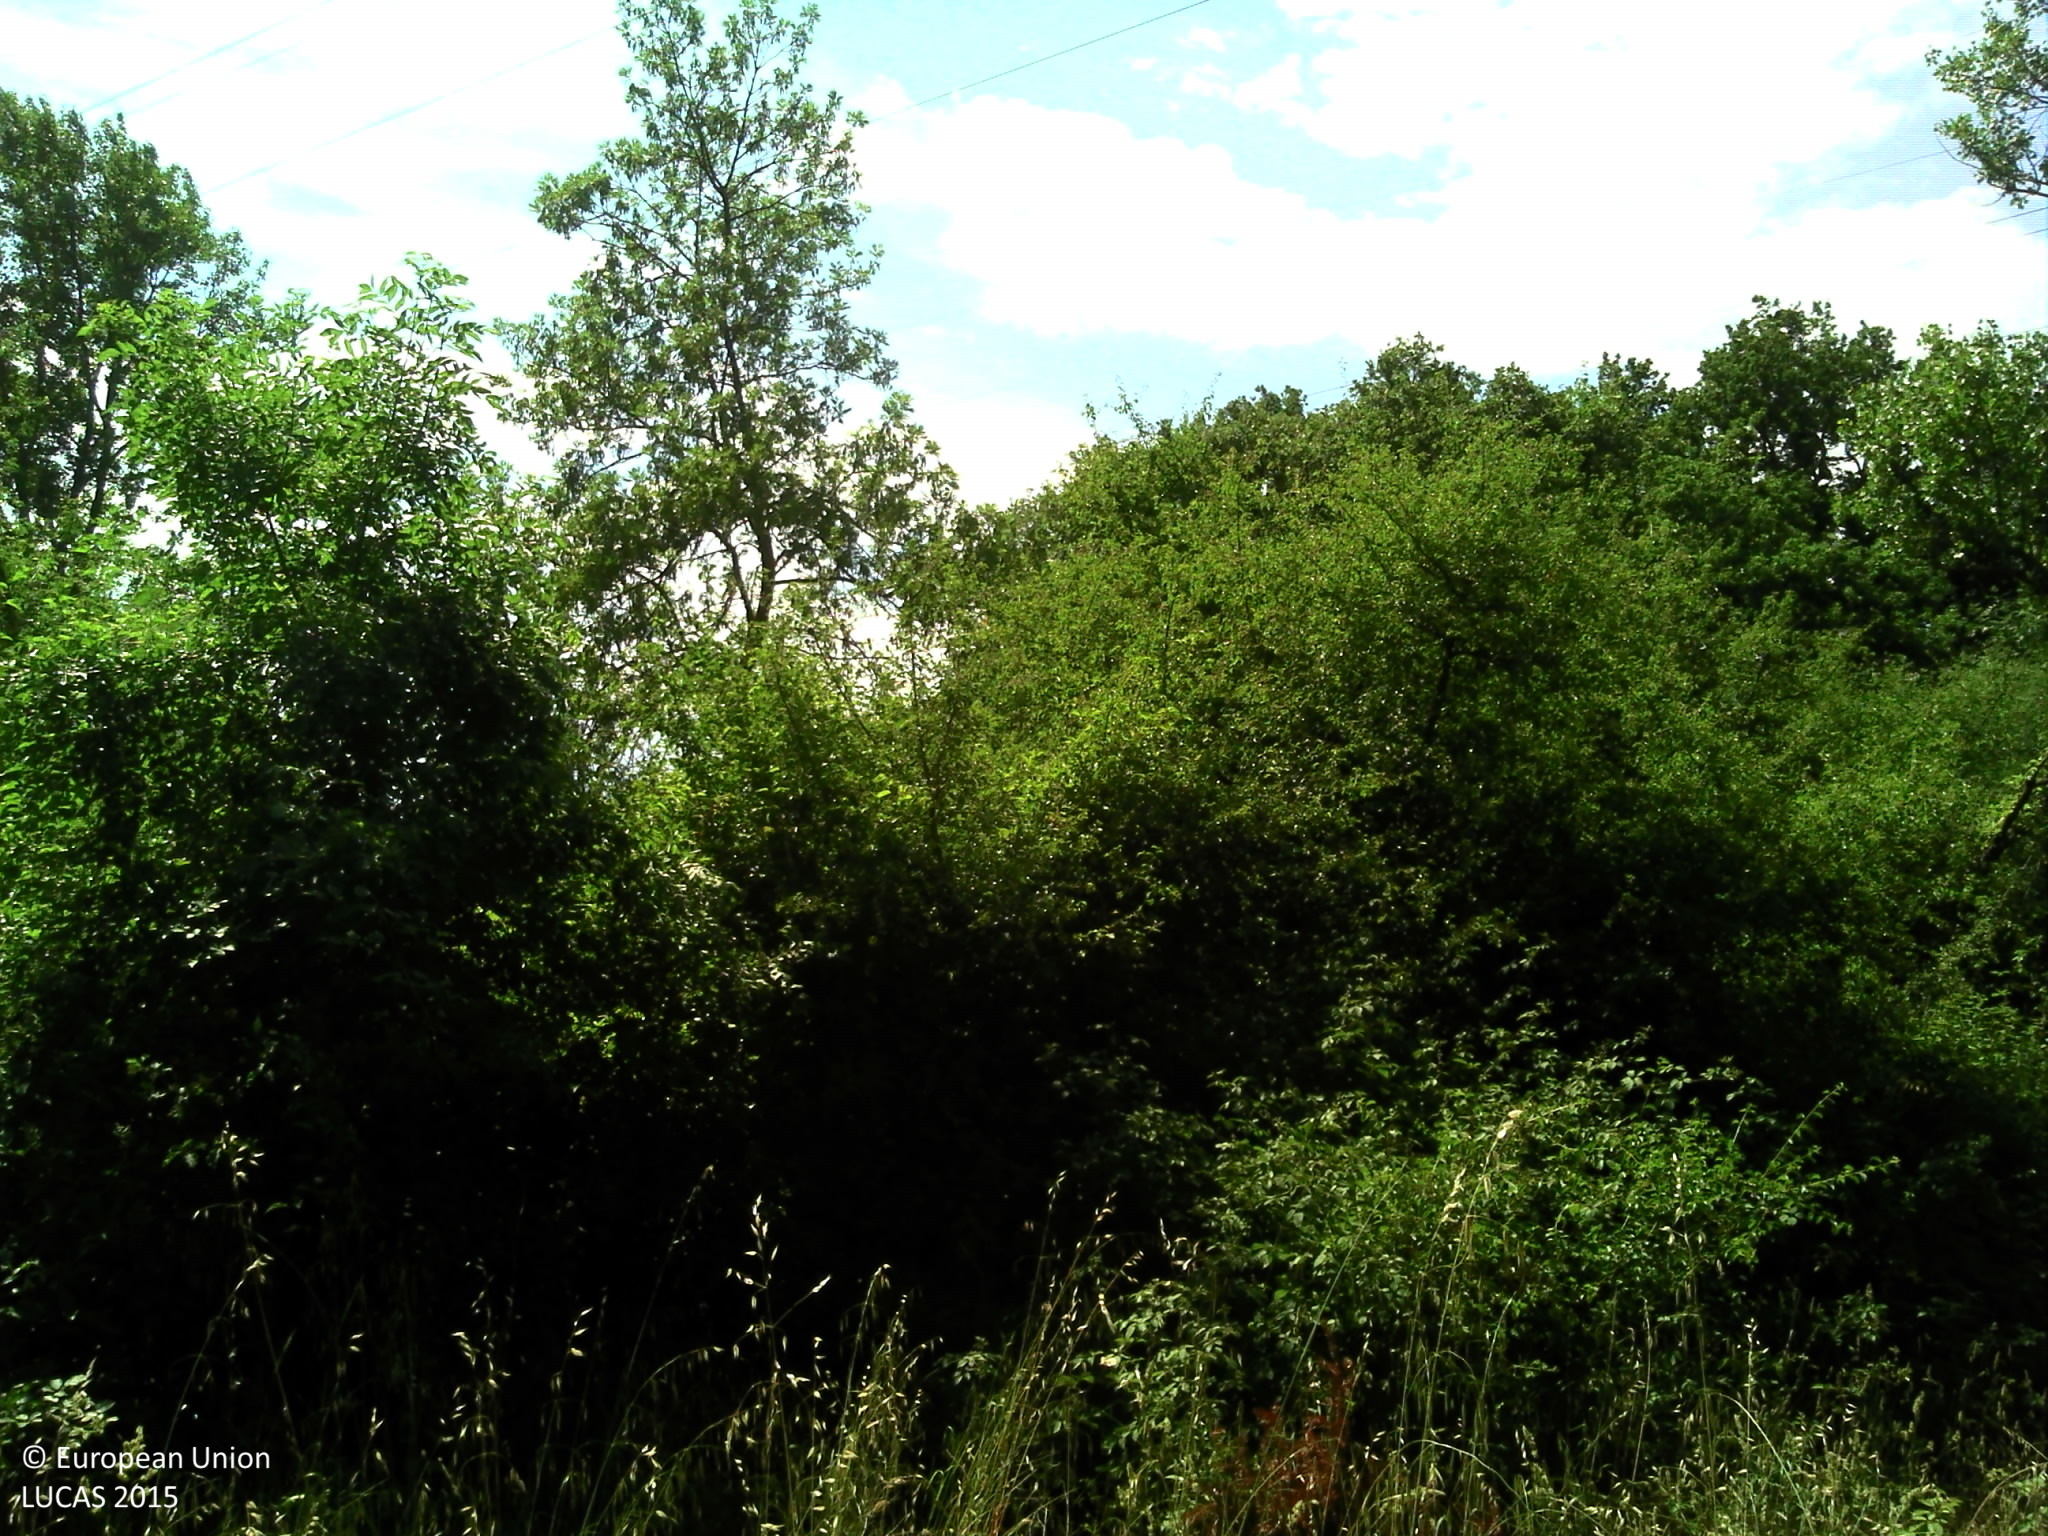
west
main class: Woodland
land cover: Broadleaved woodland
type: thermophilous deciduous forest
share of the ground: > 75 %
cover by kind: broadleaved forest trees 95 %, herbaceous plants 5 %
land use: Semi-natural and natural areas not in use
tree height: > 5 m
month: May
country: FR
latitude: 45.0029
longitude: 4.9183
